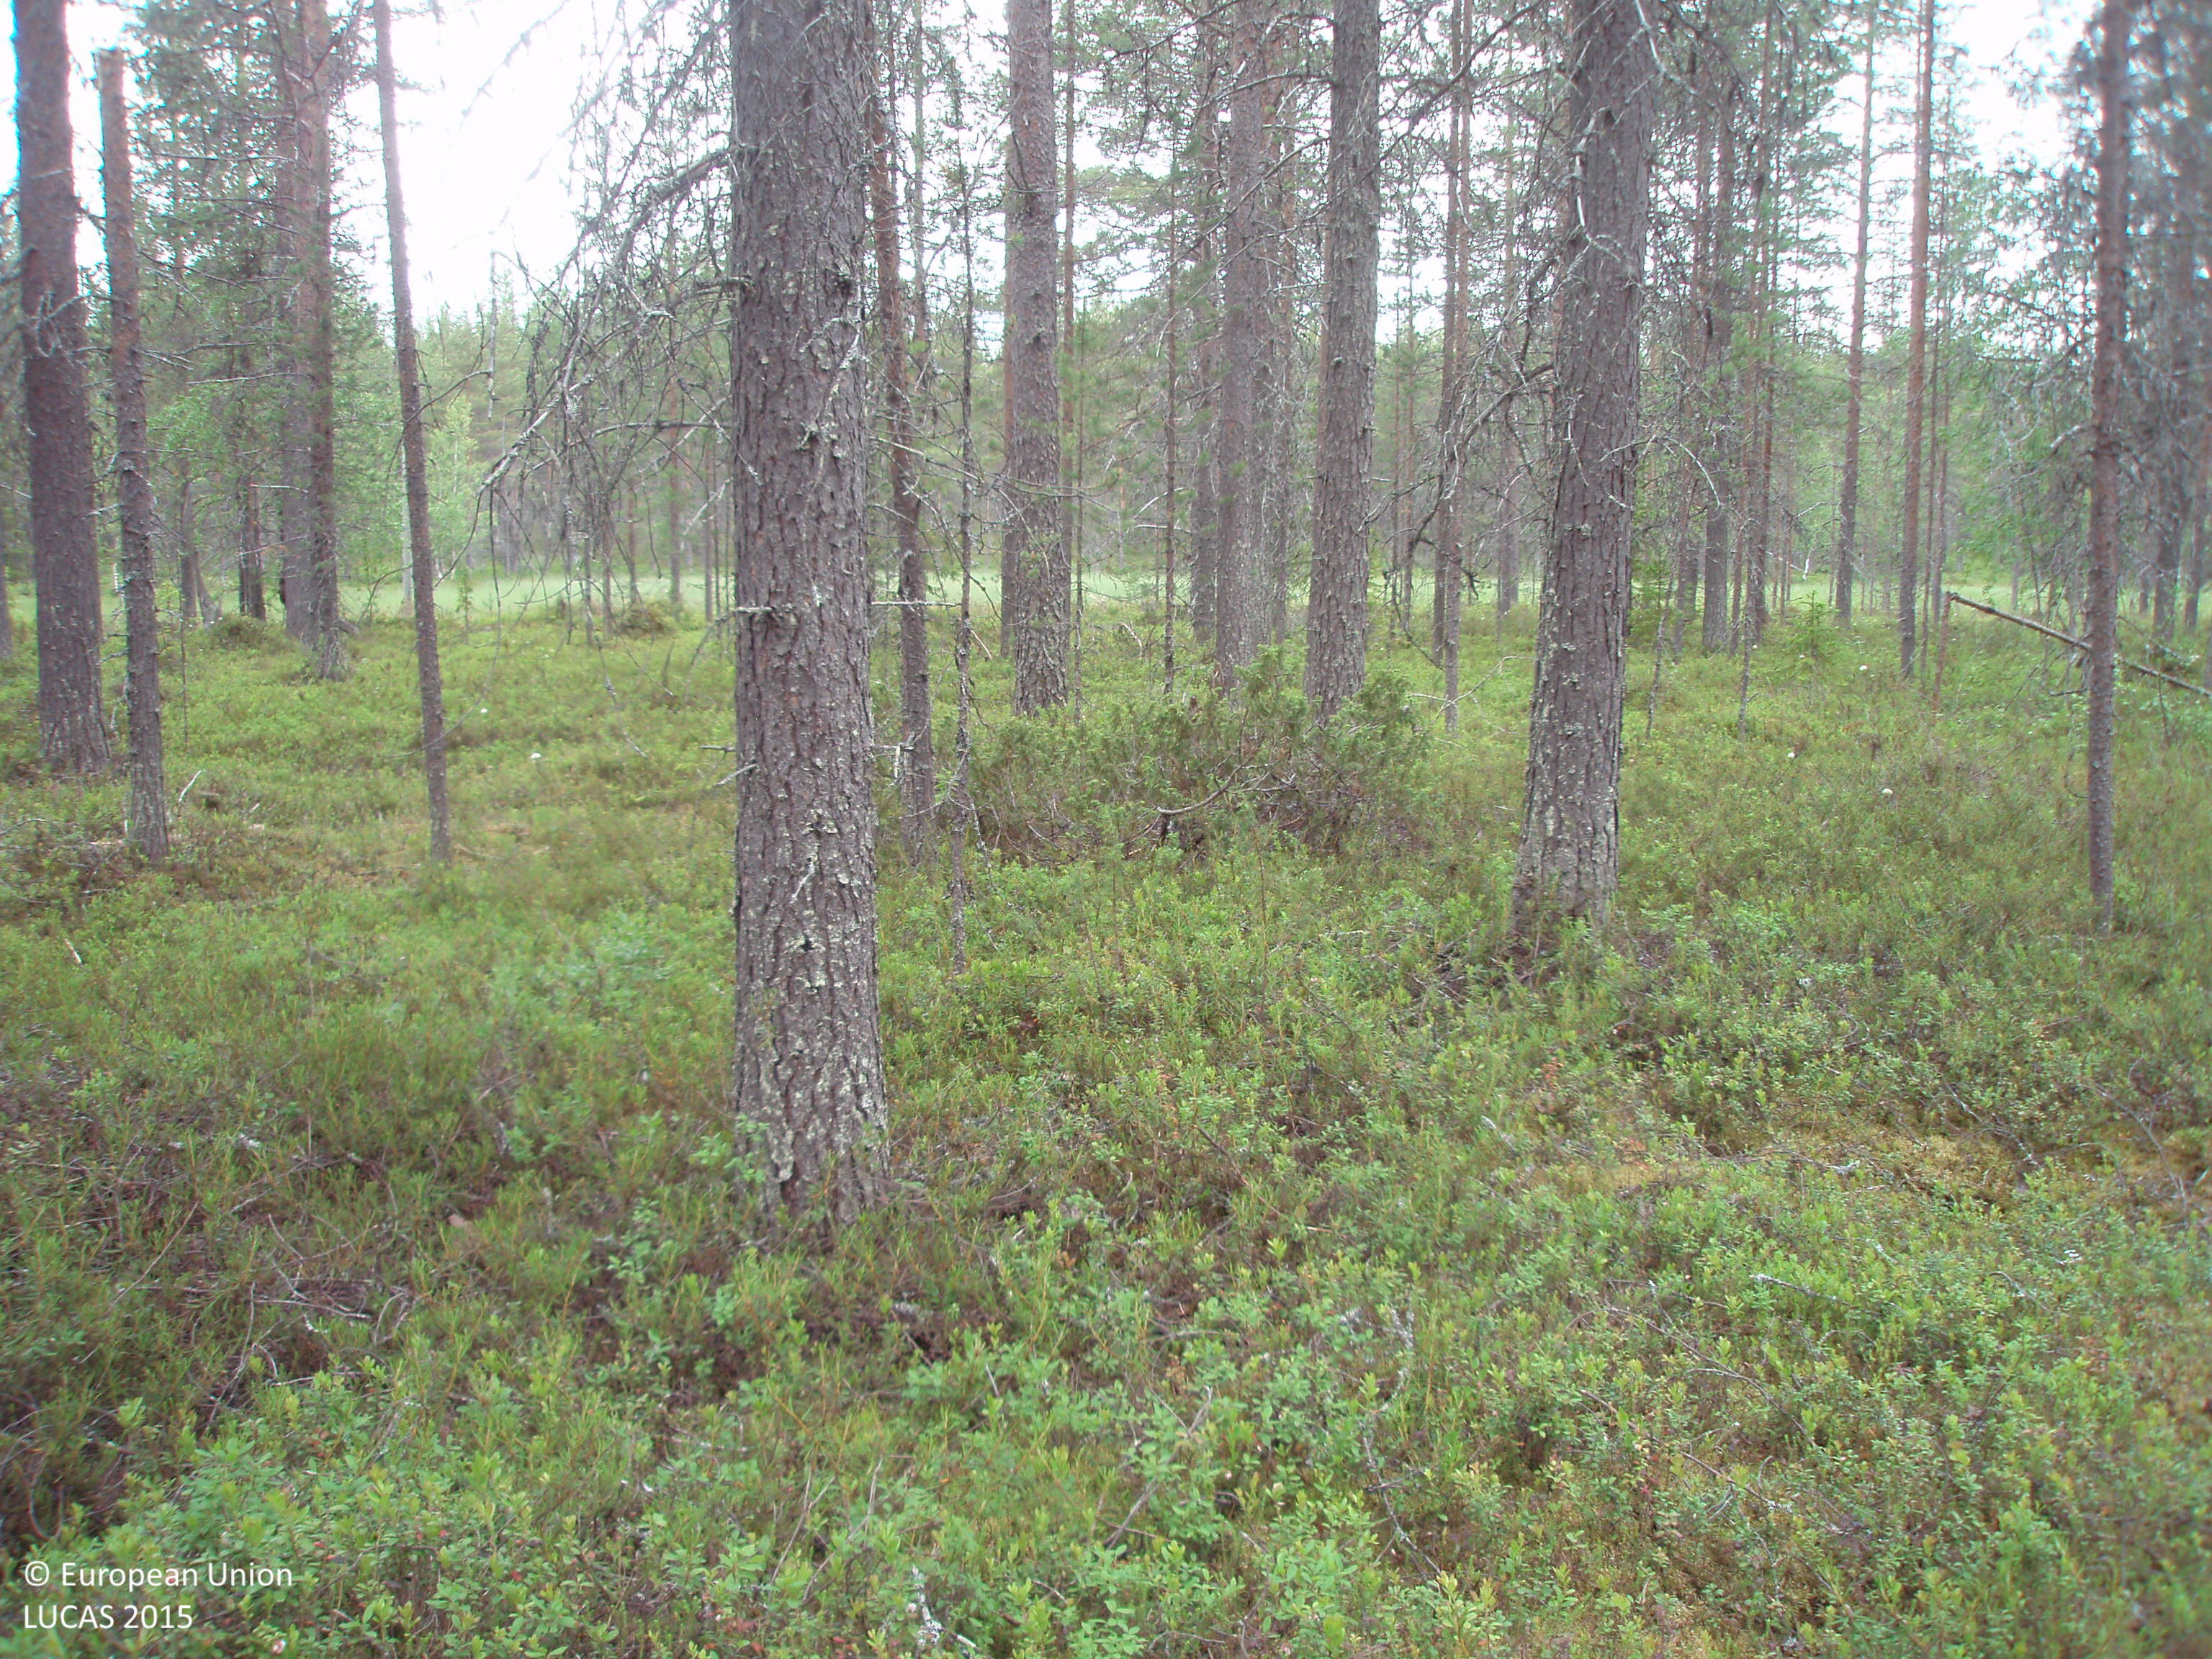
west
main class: Woodland
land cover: Pine dominated coniferous woodland
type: boreal forest
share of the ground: > 75 %
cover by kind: coniferous forest trees 75 %, shrubs 25 %
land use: Forestry
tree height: > 5 m
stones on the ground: < 10 %
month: July
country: FI
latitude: 67.3108
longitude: 28.2202
